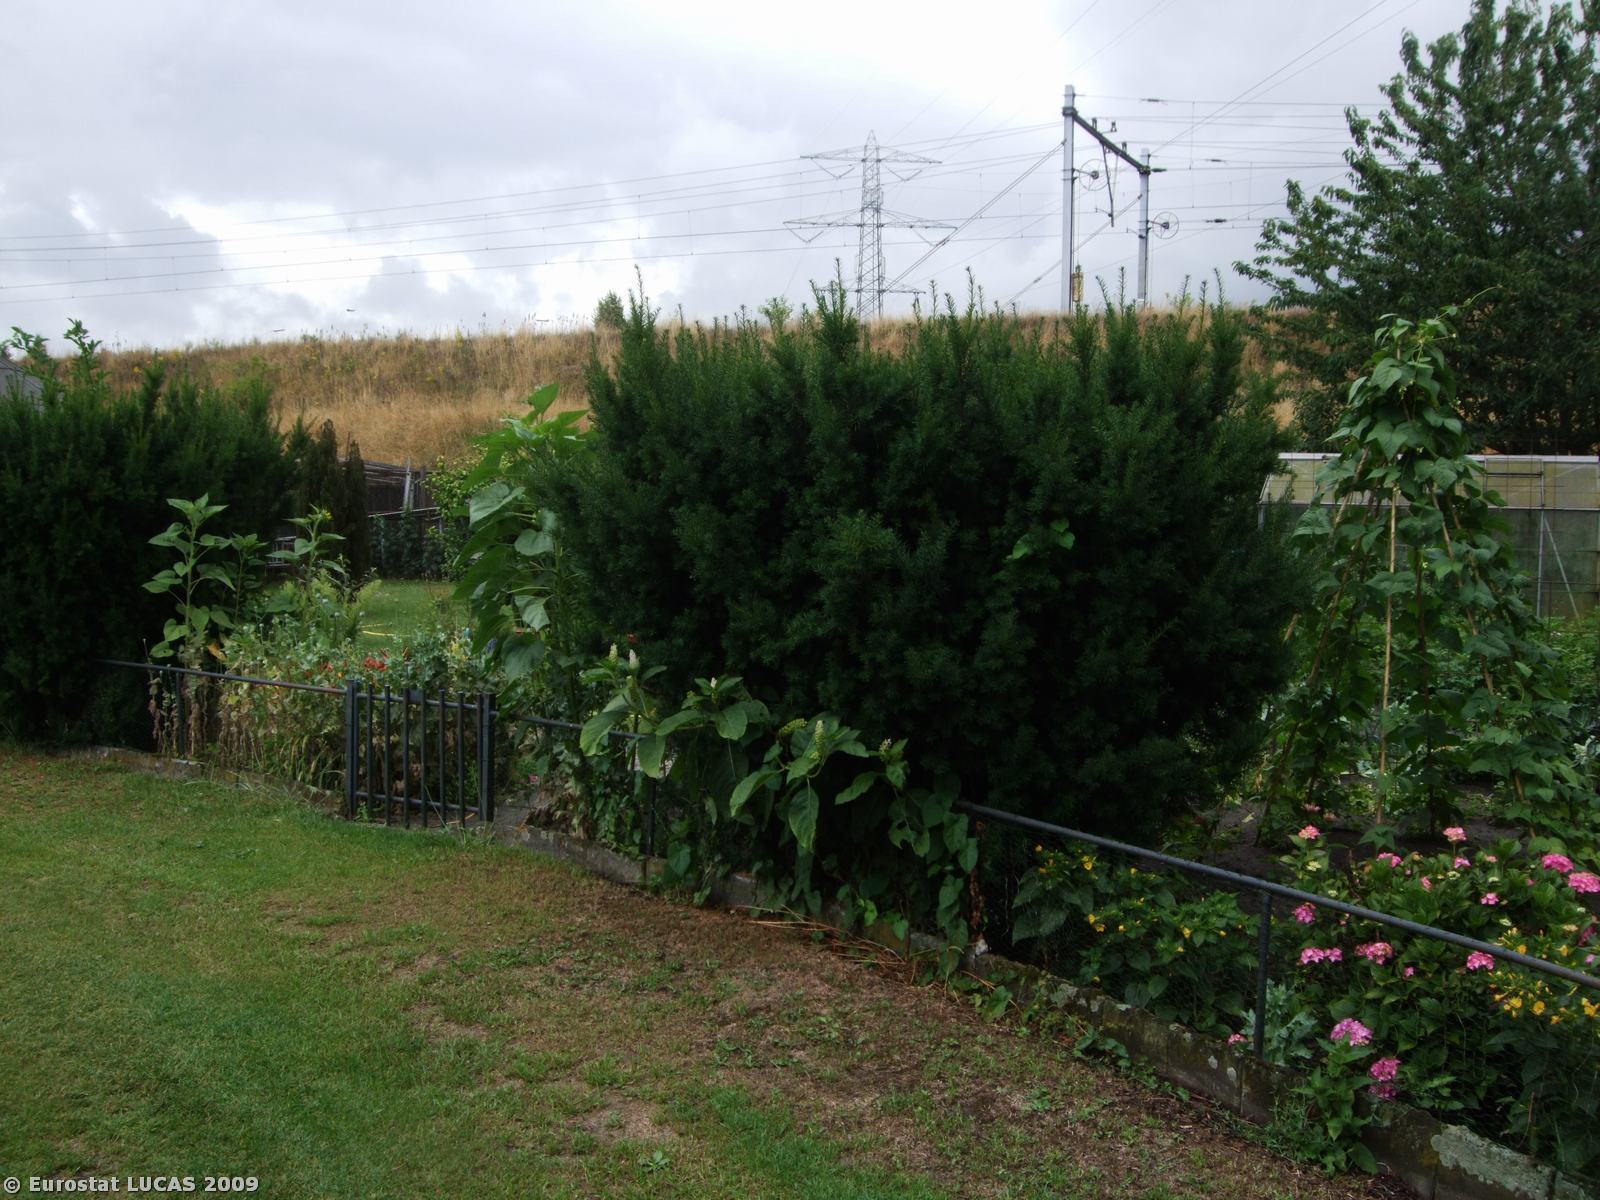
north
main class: Artificial land
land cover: Buildings with 1 to 3 floors
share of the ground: 10 - 25 %
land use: Amenities, museums, leisure
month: July
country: NL
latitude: 51.4714
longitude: 5.6940
